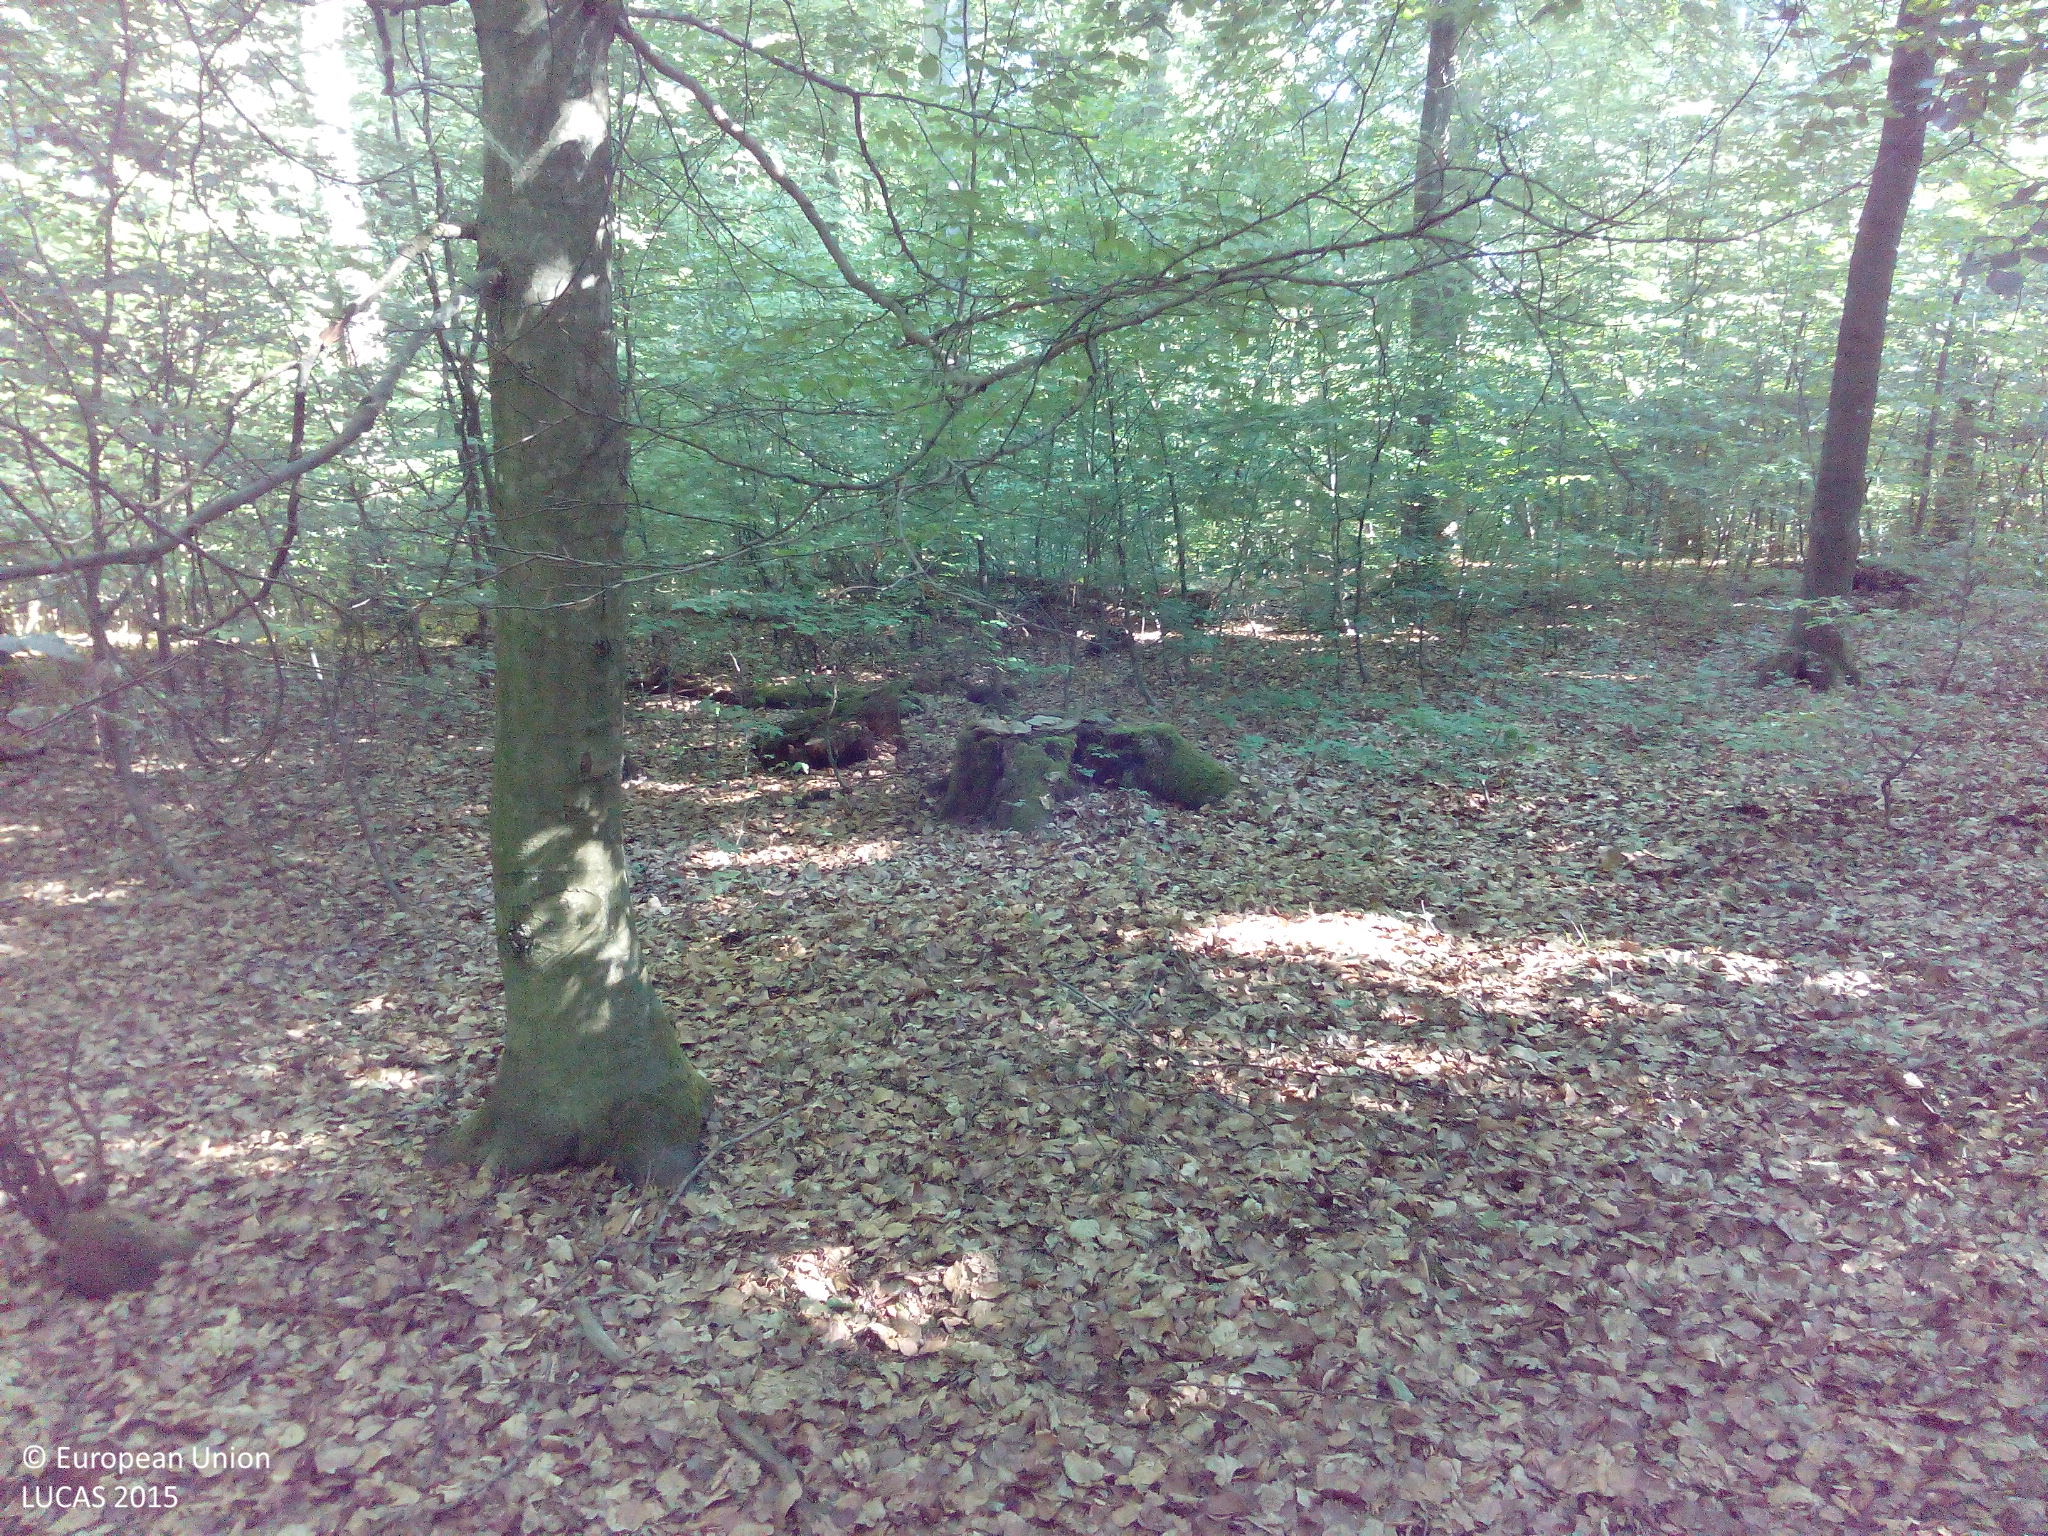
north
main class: Woodland
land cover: Broadleaved woodland
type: mesophytic deciduous forest
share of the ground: > 75 %
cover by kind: broadleaved forest trees 95 %, unconsolidated bare surface 5 %
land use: Forestry
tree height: > 5 m
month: July
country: DE
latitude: 50.0773
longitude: 8.0301
